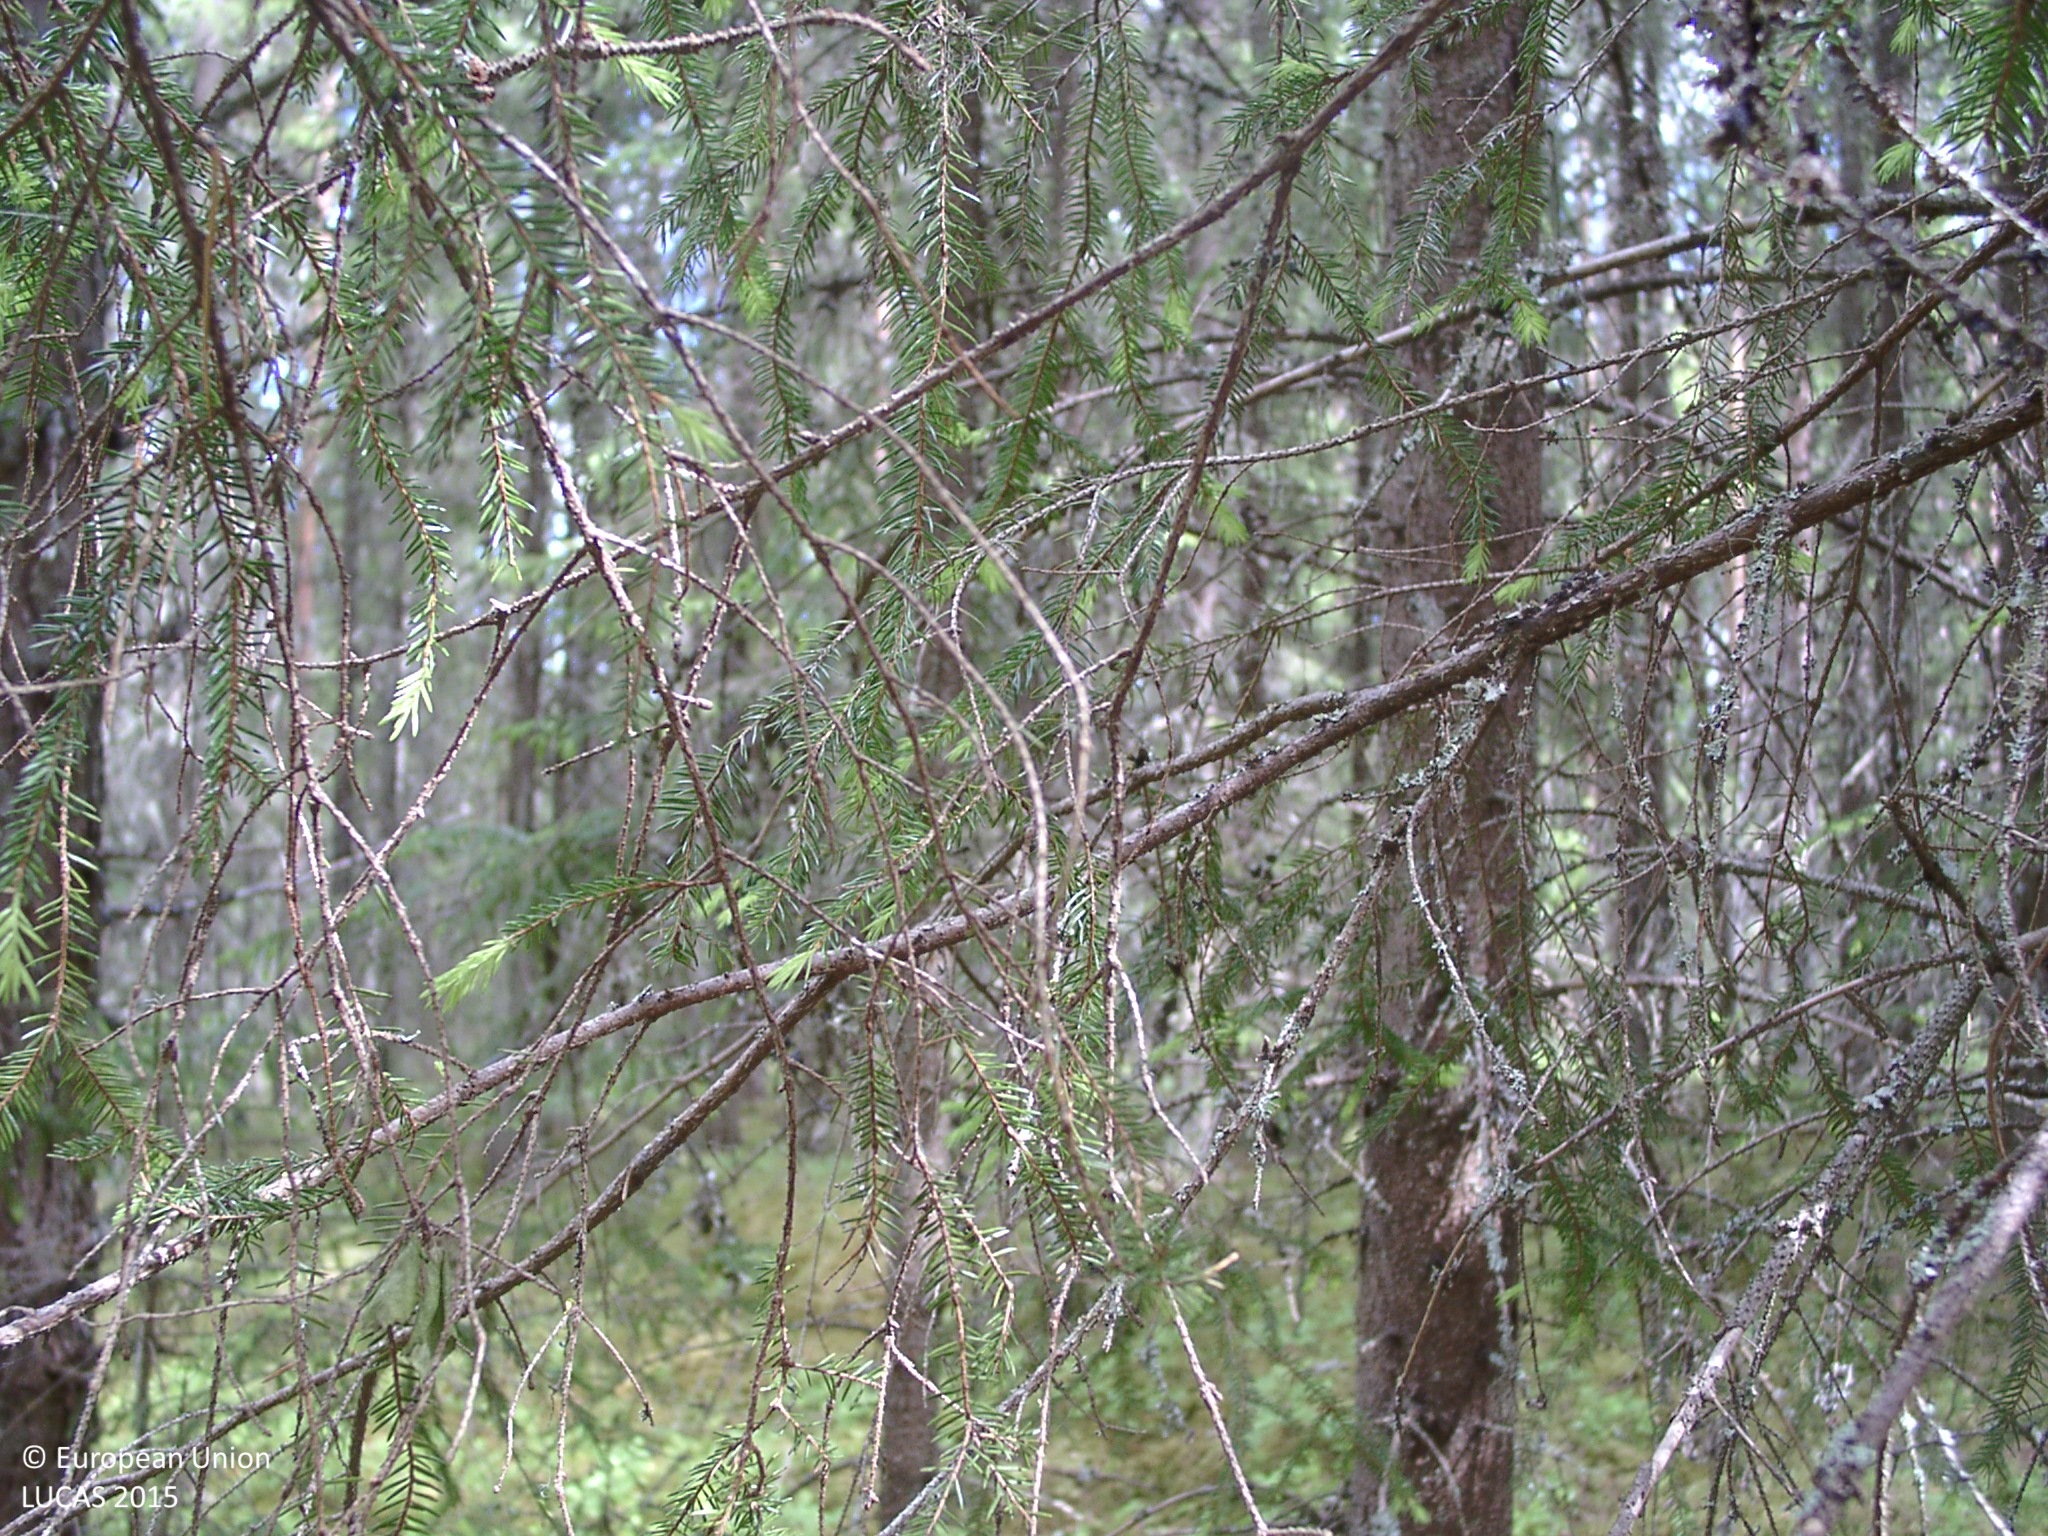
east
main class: Woodland
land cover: Spruce dominated coniferous woodland
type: boreal forest
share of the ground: > 75 %
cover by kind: coniferous forest trees 75 %, lichens and mosses 20 %, shrubs 5 %
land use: Semi-natural and natural areas not in use
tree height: > 5 m
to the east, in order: Spruce dominated coniferous woodland; Other coniferous woodland; Lichens and moss; Other coniferous woodland; Spruce dominated coniferous woodland; Ditches and canals; Spruce dominated coniferous woodland
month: June
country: FI
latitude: 61.8447
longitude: 24.5536
